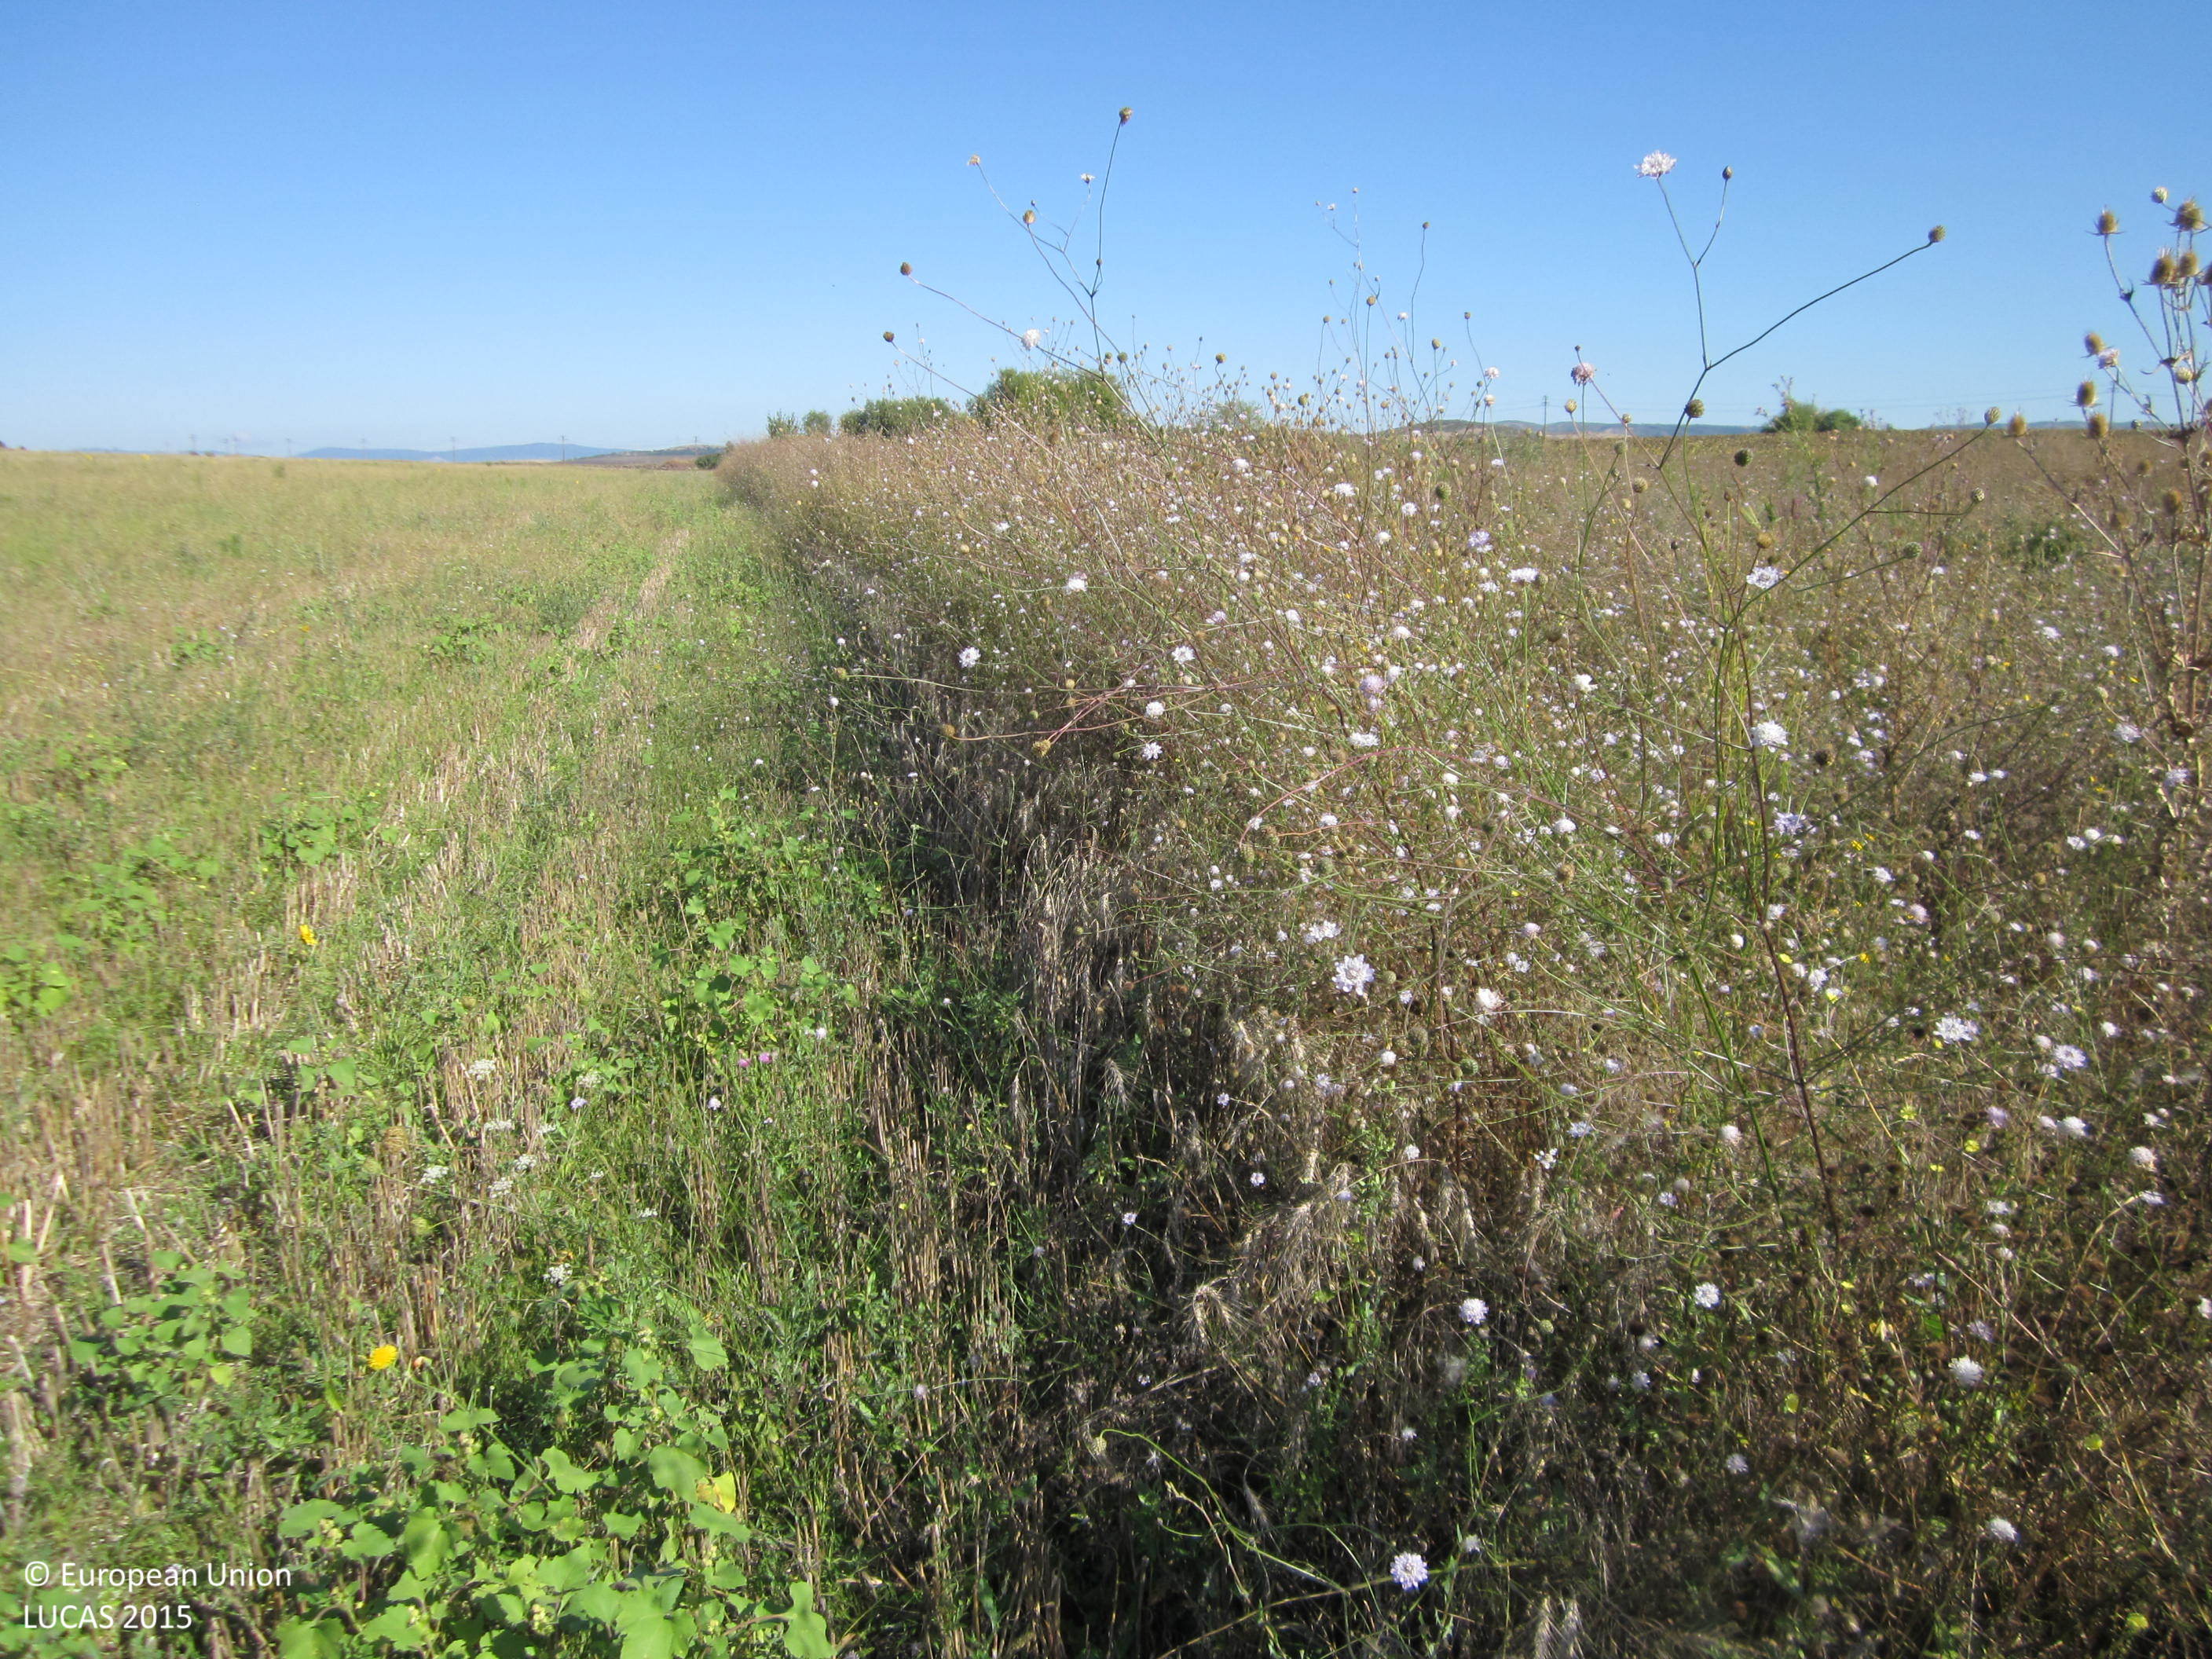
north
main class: Grassland
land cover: Grassland without tree/shrub cover
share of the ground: > 75 %
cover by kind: herbaceous plants 100 %
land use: Semi-natural and natural areas not in use
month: September
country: BG
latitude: 42.5837
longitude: 27.3315
